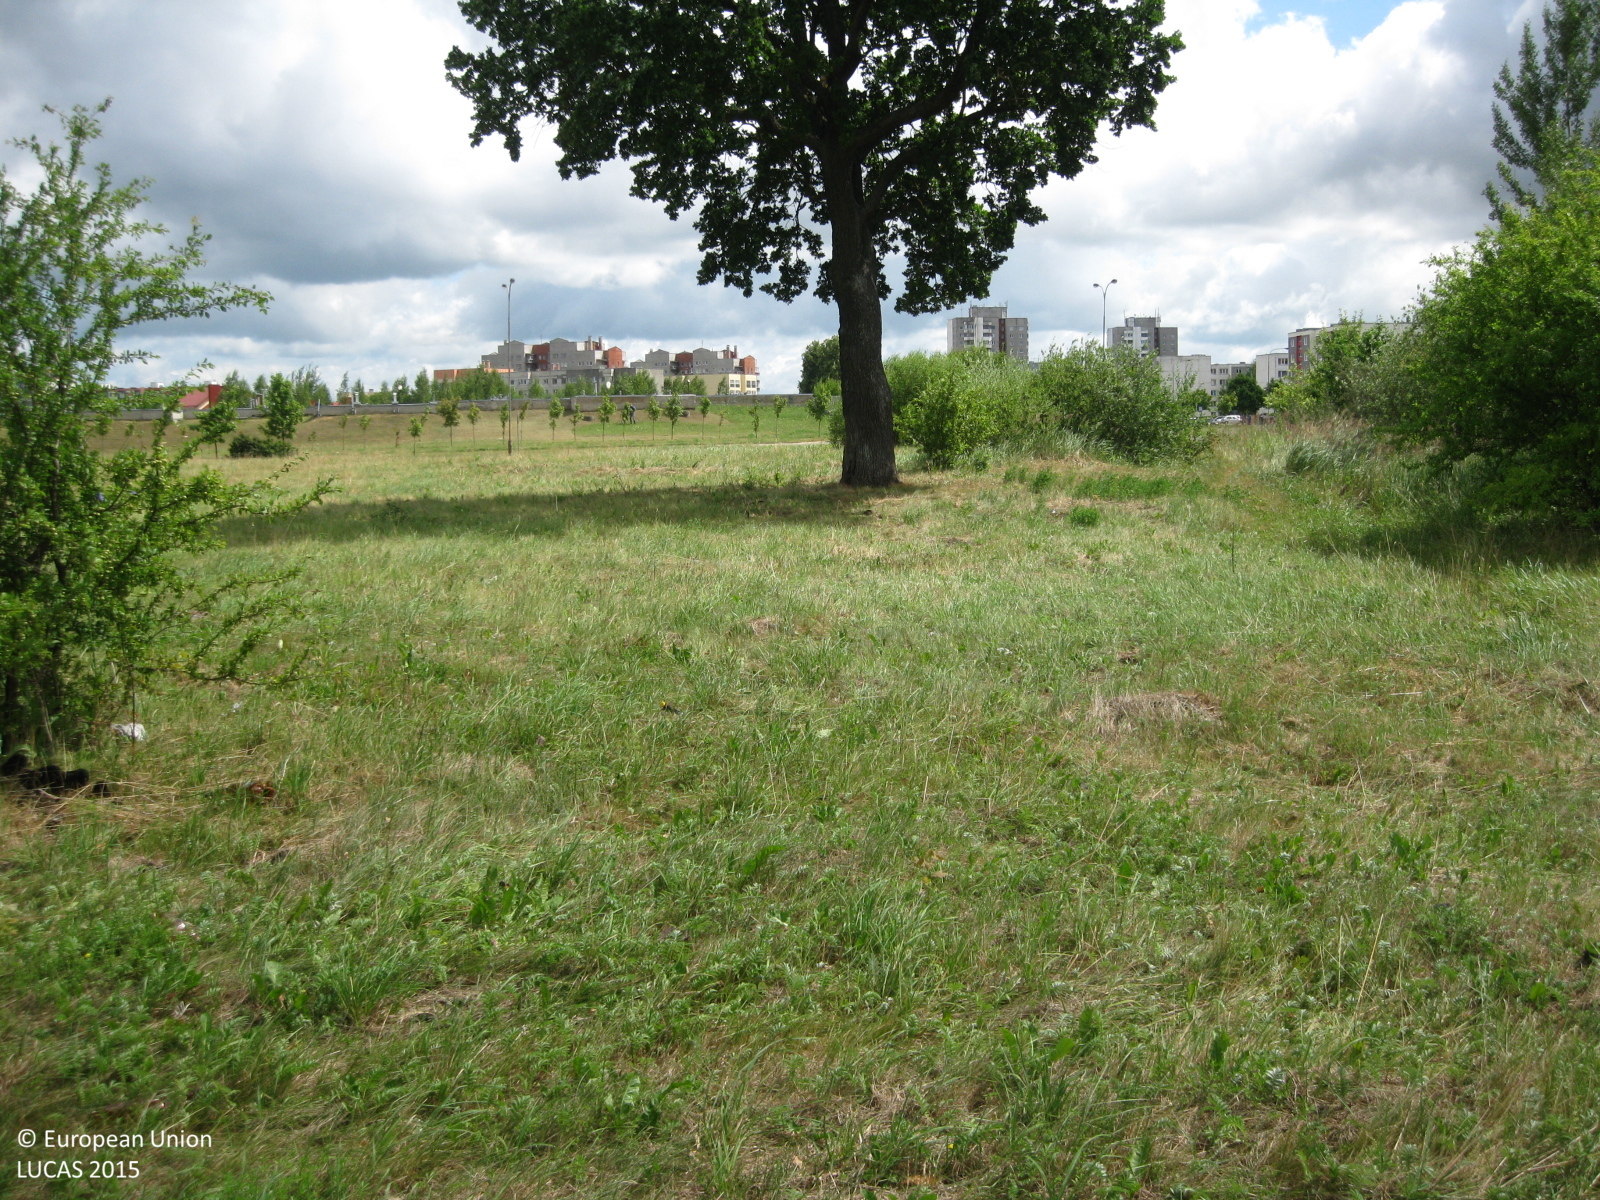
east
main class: Grassland
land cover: Grassland with sparse tree/shrub cover
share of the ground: > 75 %
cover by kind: herbaceous plants 90 %, broadleaved forest trees 5 %, shrubs 5 %
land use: Amenities, museums, leisure
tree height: > 5 m
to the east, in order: Grassland with sparse tree/shrub cover; Artificial constructions in urban areas
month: July
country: LT
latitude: 55.7270
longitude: 24.3139
